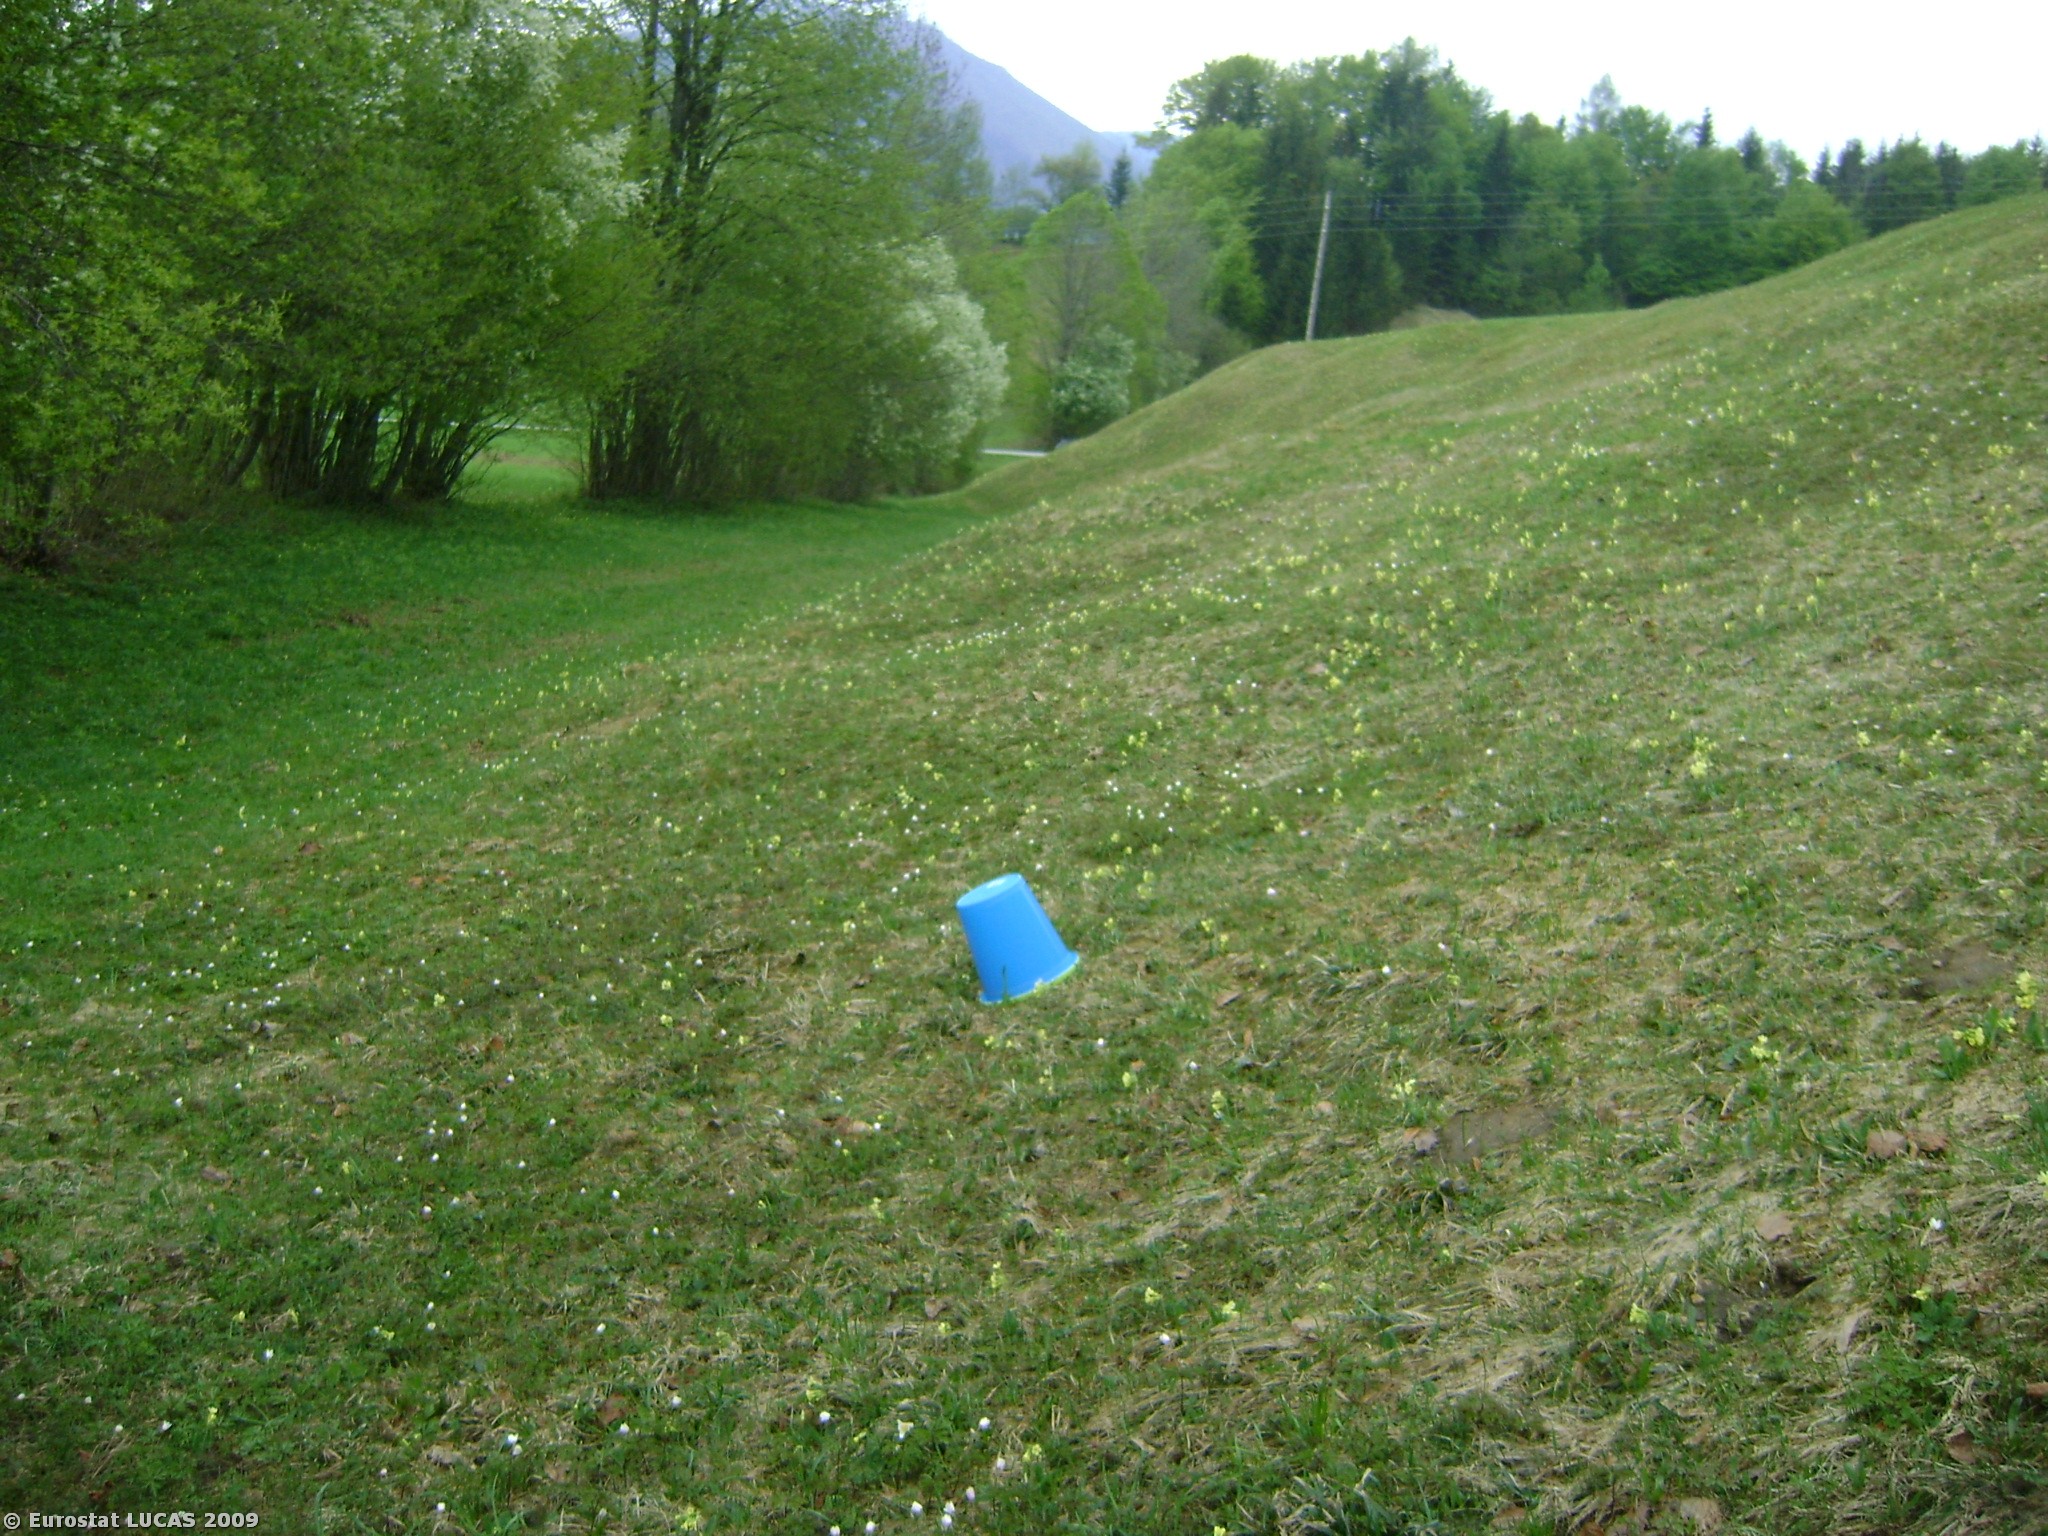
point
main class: Grassland
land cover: Grassland without tree/shrub cover
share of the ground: > 75 %
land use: Agriculture (excluding fallow land and kitchen gardens)
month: May
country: AT
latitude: 47.7625
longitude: 13.2140
